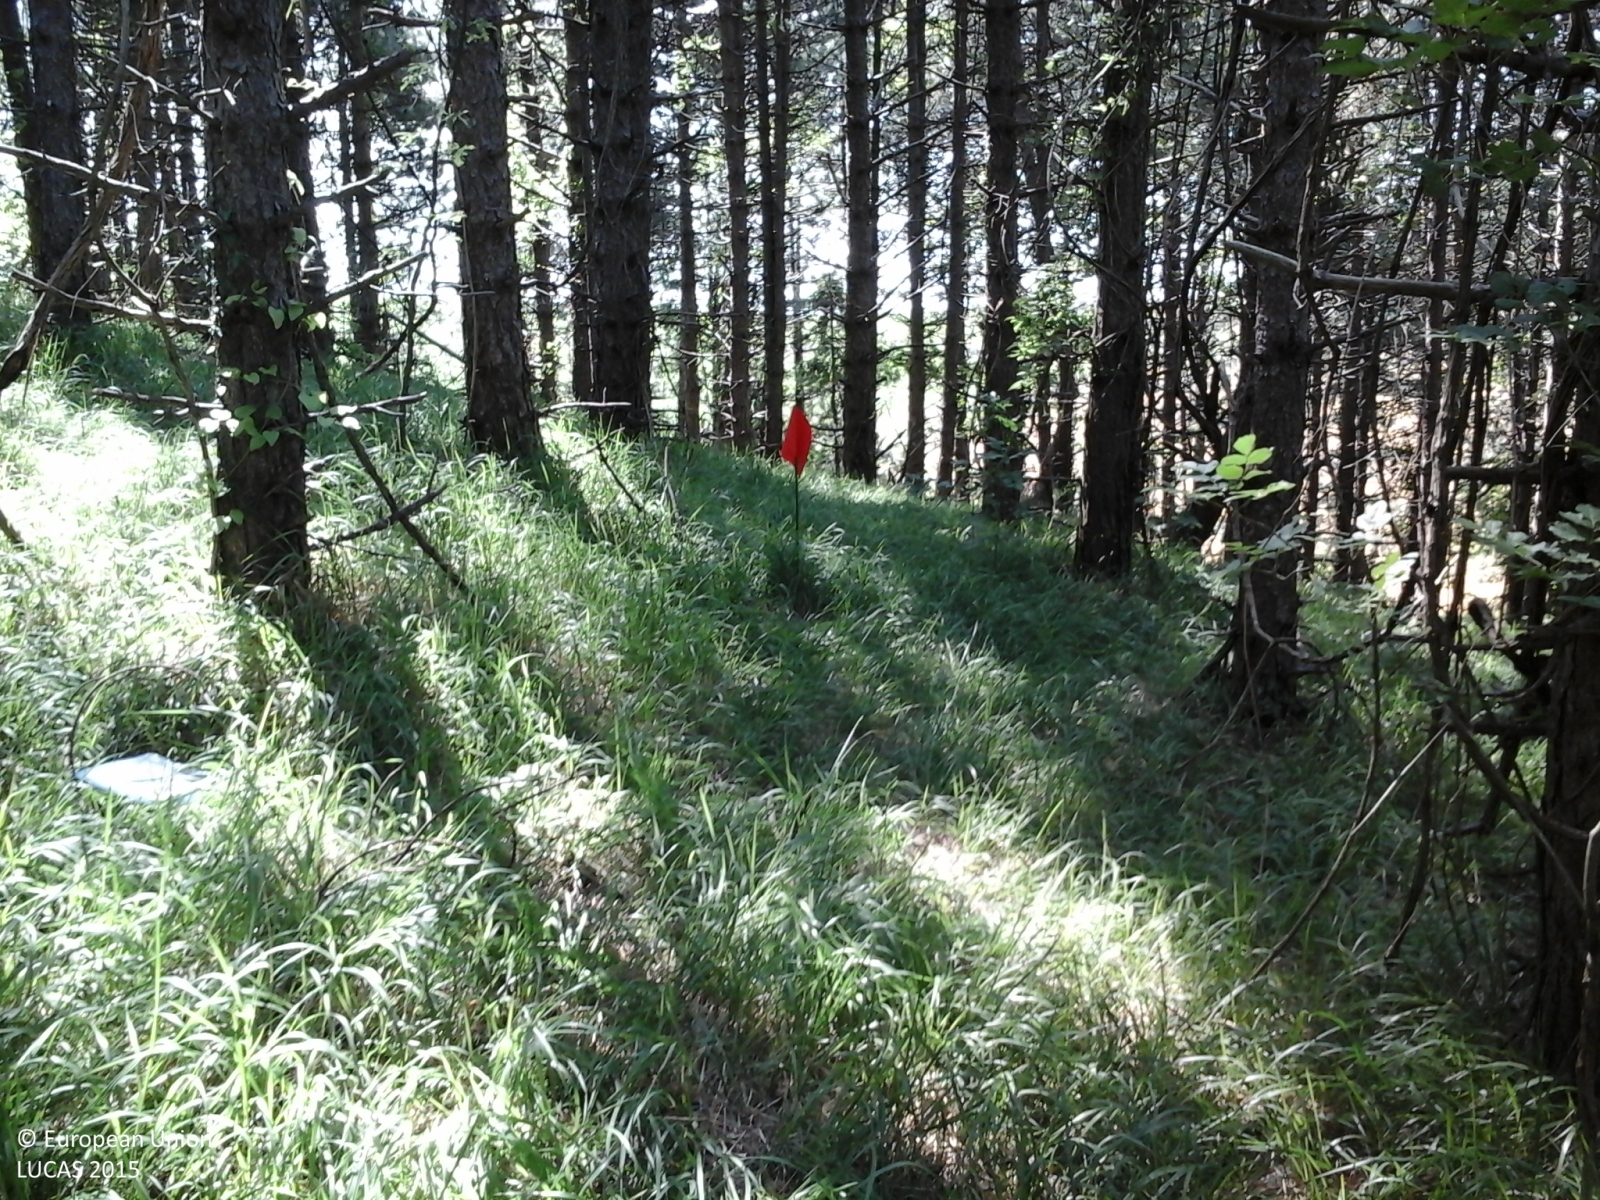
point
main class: Woodland
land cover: Pine dominated coniferous woodland
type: hemiboreal forest and nemoral coniferous forest and mixed broadleaved-coniferous forest
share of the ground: > 75 %
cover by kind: coniferous forest trees 100 %
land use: Forestry
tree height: > 5 m
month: June
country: IT
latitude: 44.1392
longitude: 11.6337
